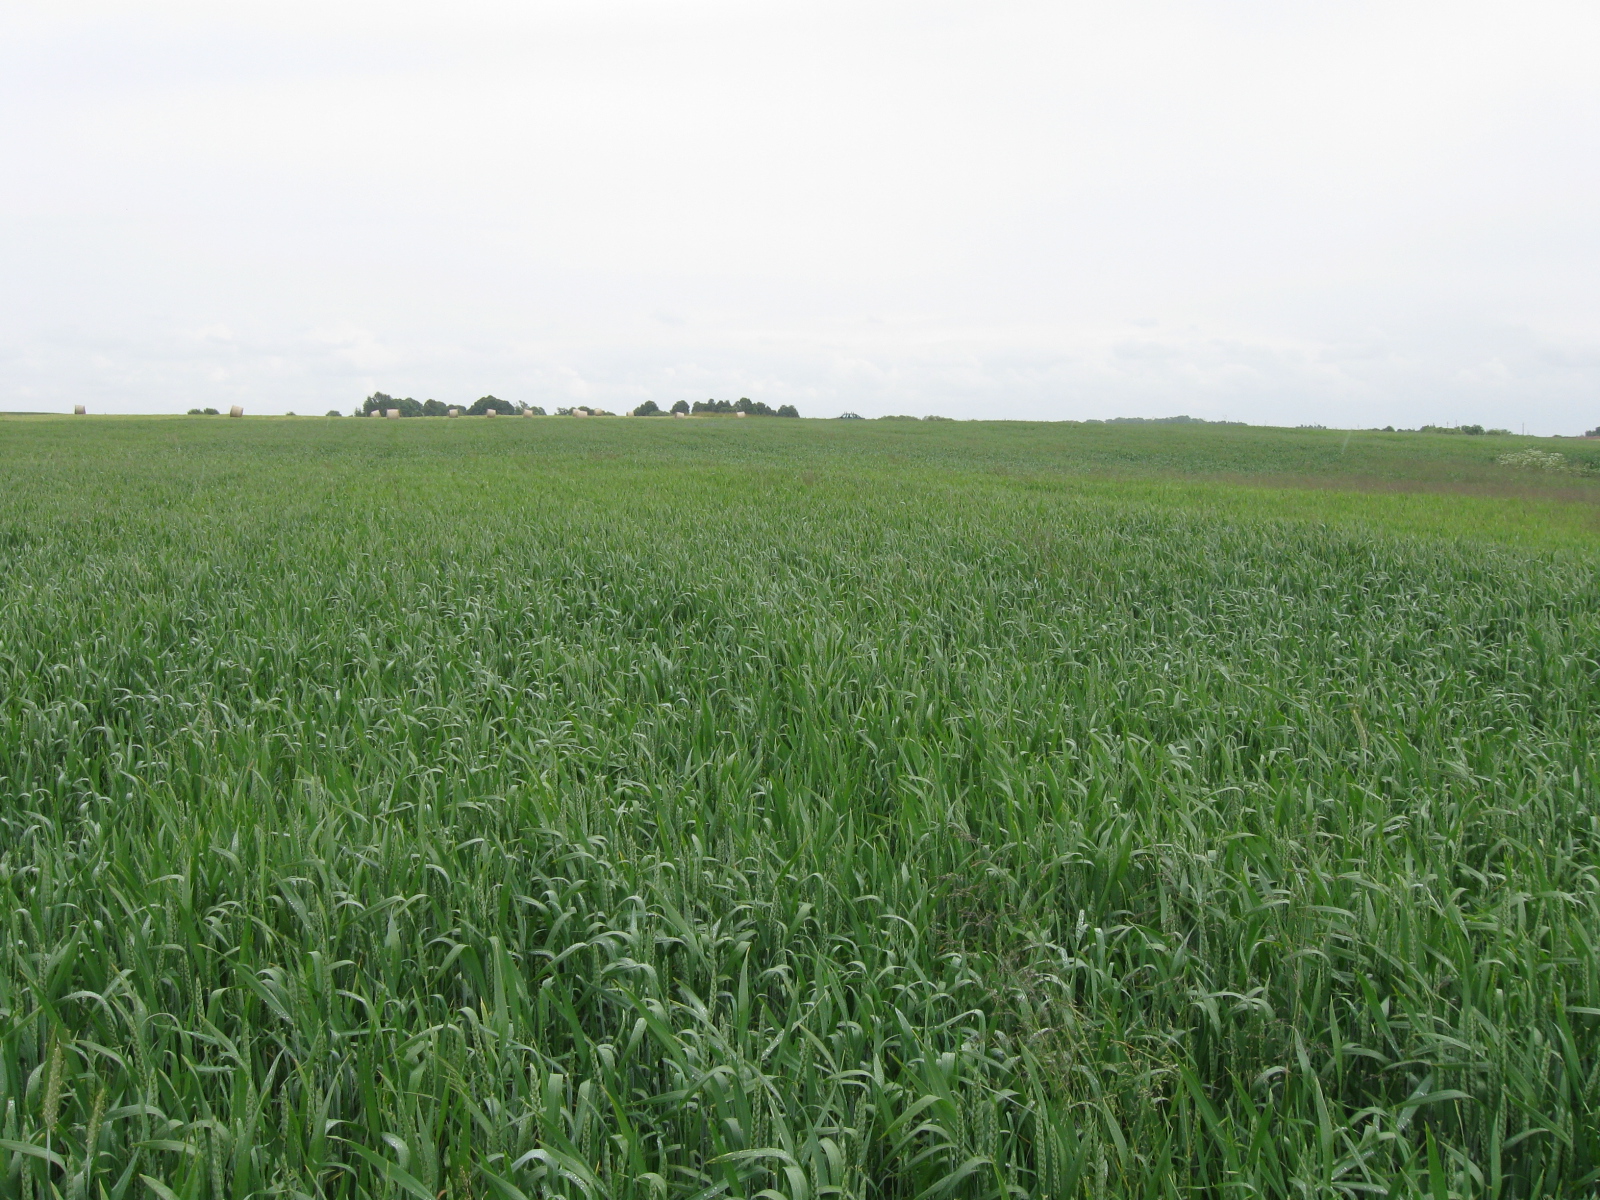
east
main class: Cropland
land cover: Common wheat
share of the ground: > 75 %
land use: Agriculture (excluding fallow land and kitchen gardens)
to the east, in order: Common wheat; Grassland without tree/shrub cover
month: June
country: LT
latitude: 54.9113
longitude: 24.5633
